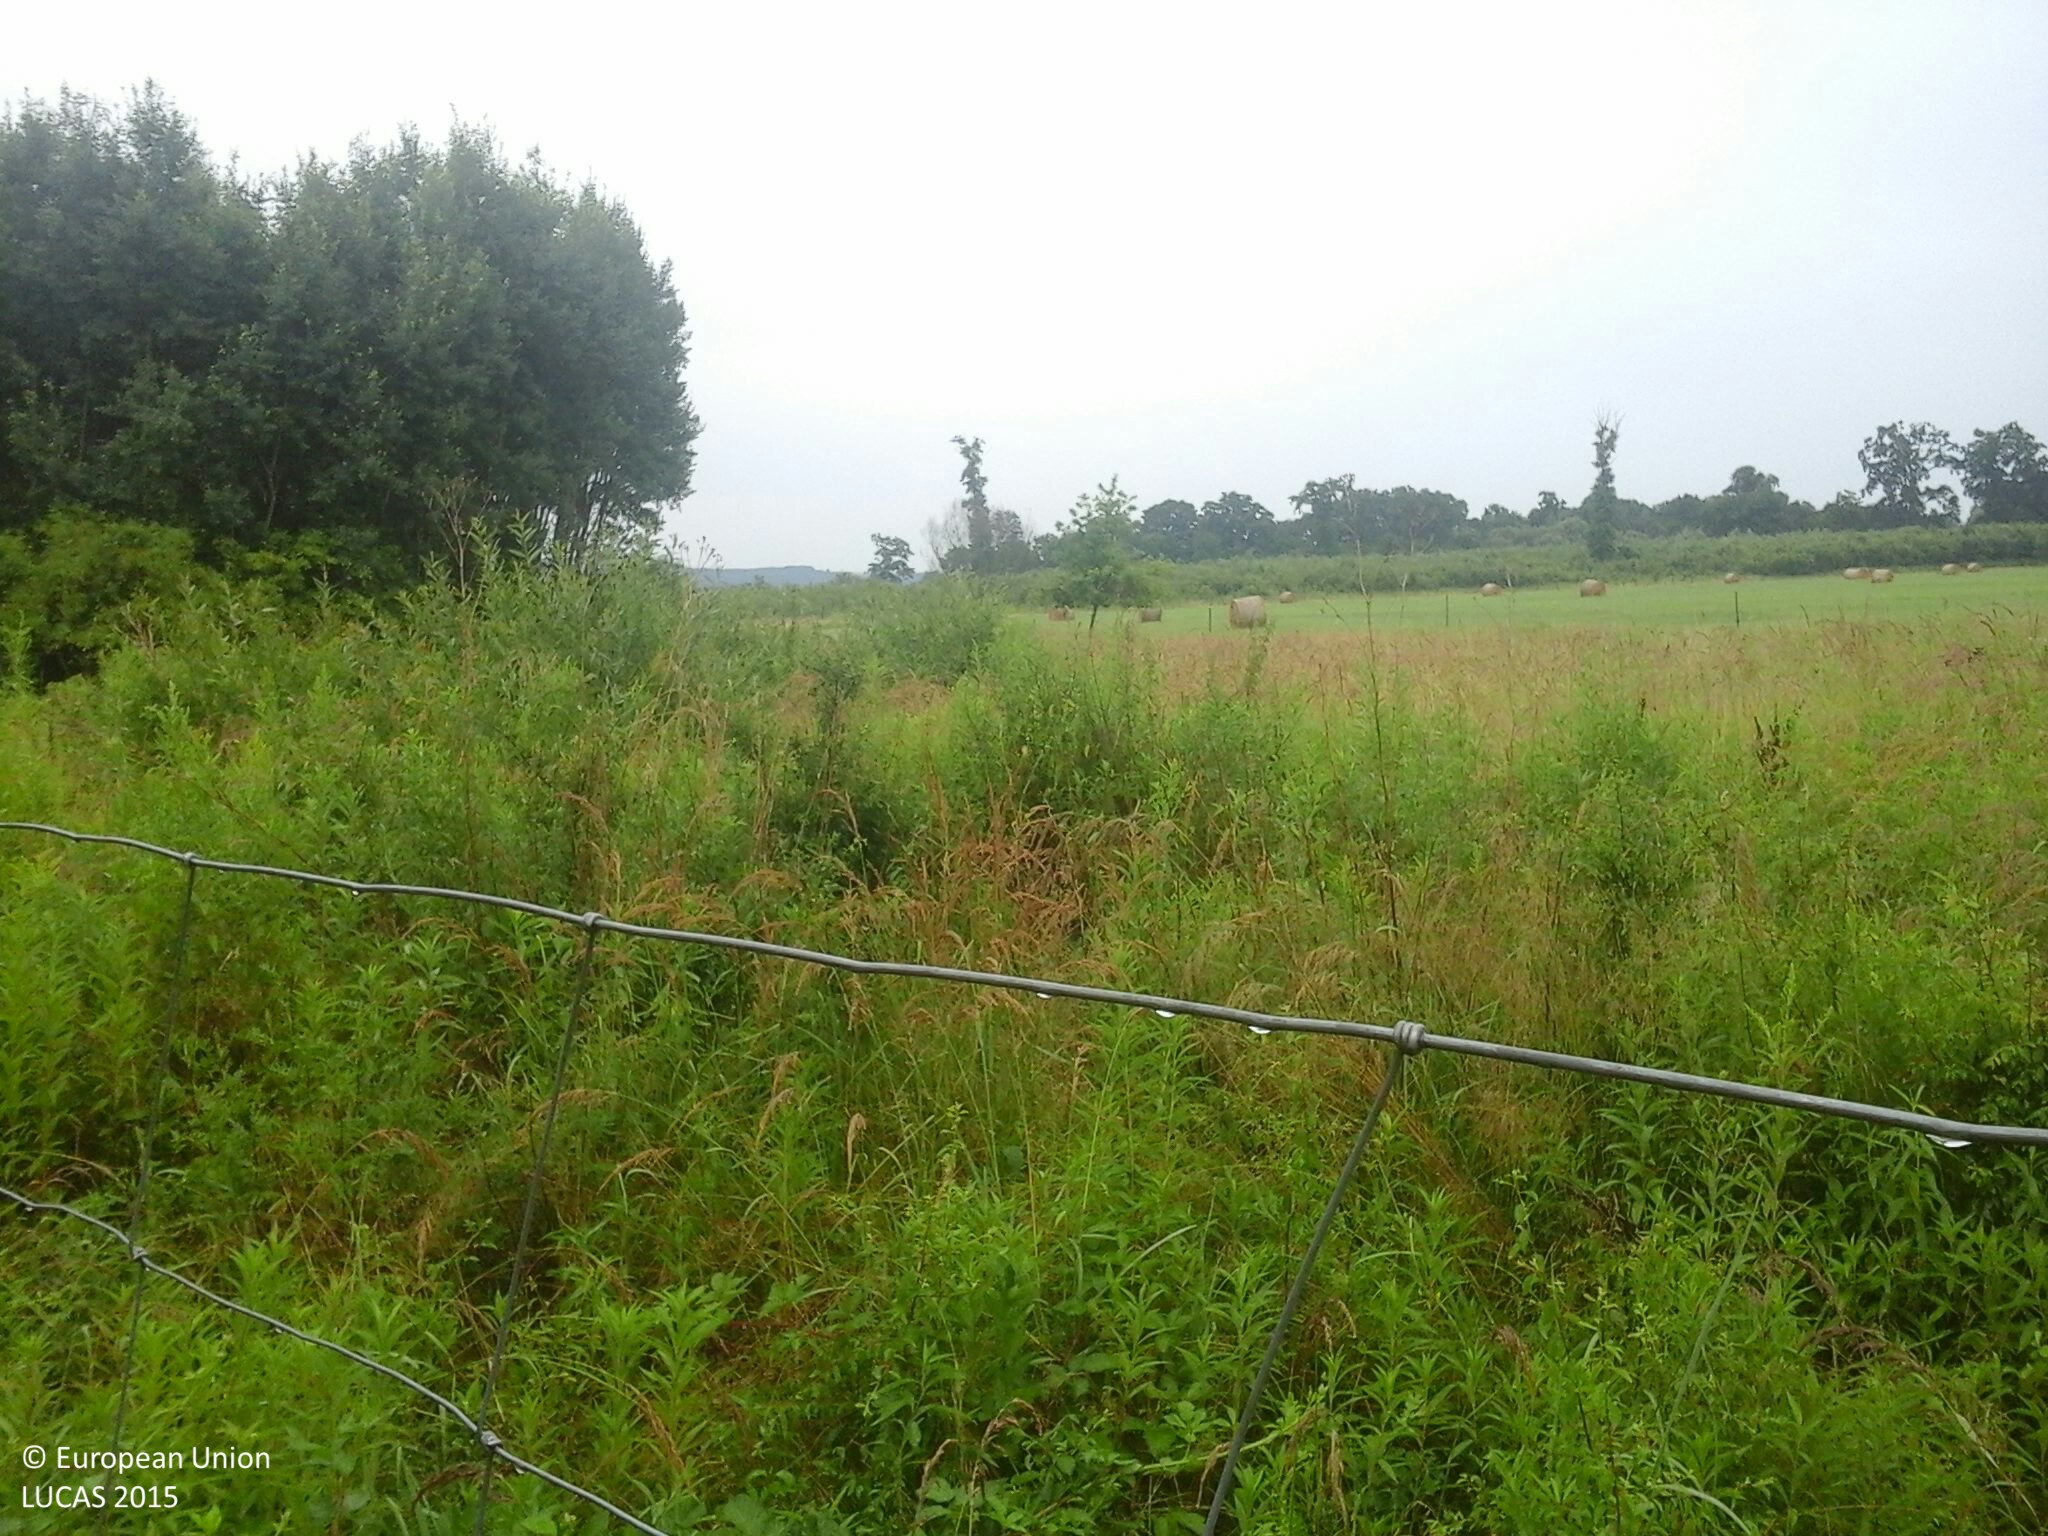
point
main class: Grassland
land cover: Grassland without tree/shrub cover
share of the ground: > 75 %
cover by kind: herbaceous plants 100 %
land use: Agriculture (excluding fallow land and kitchen gardens)
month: July
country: HU
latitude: 46.6010
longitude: 16.5680
